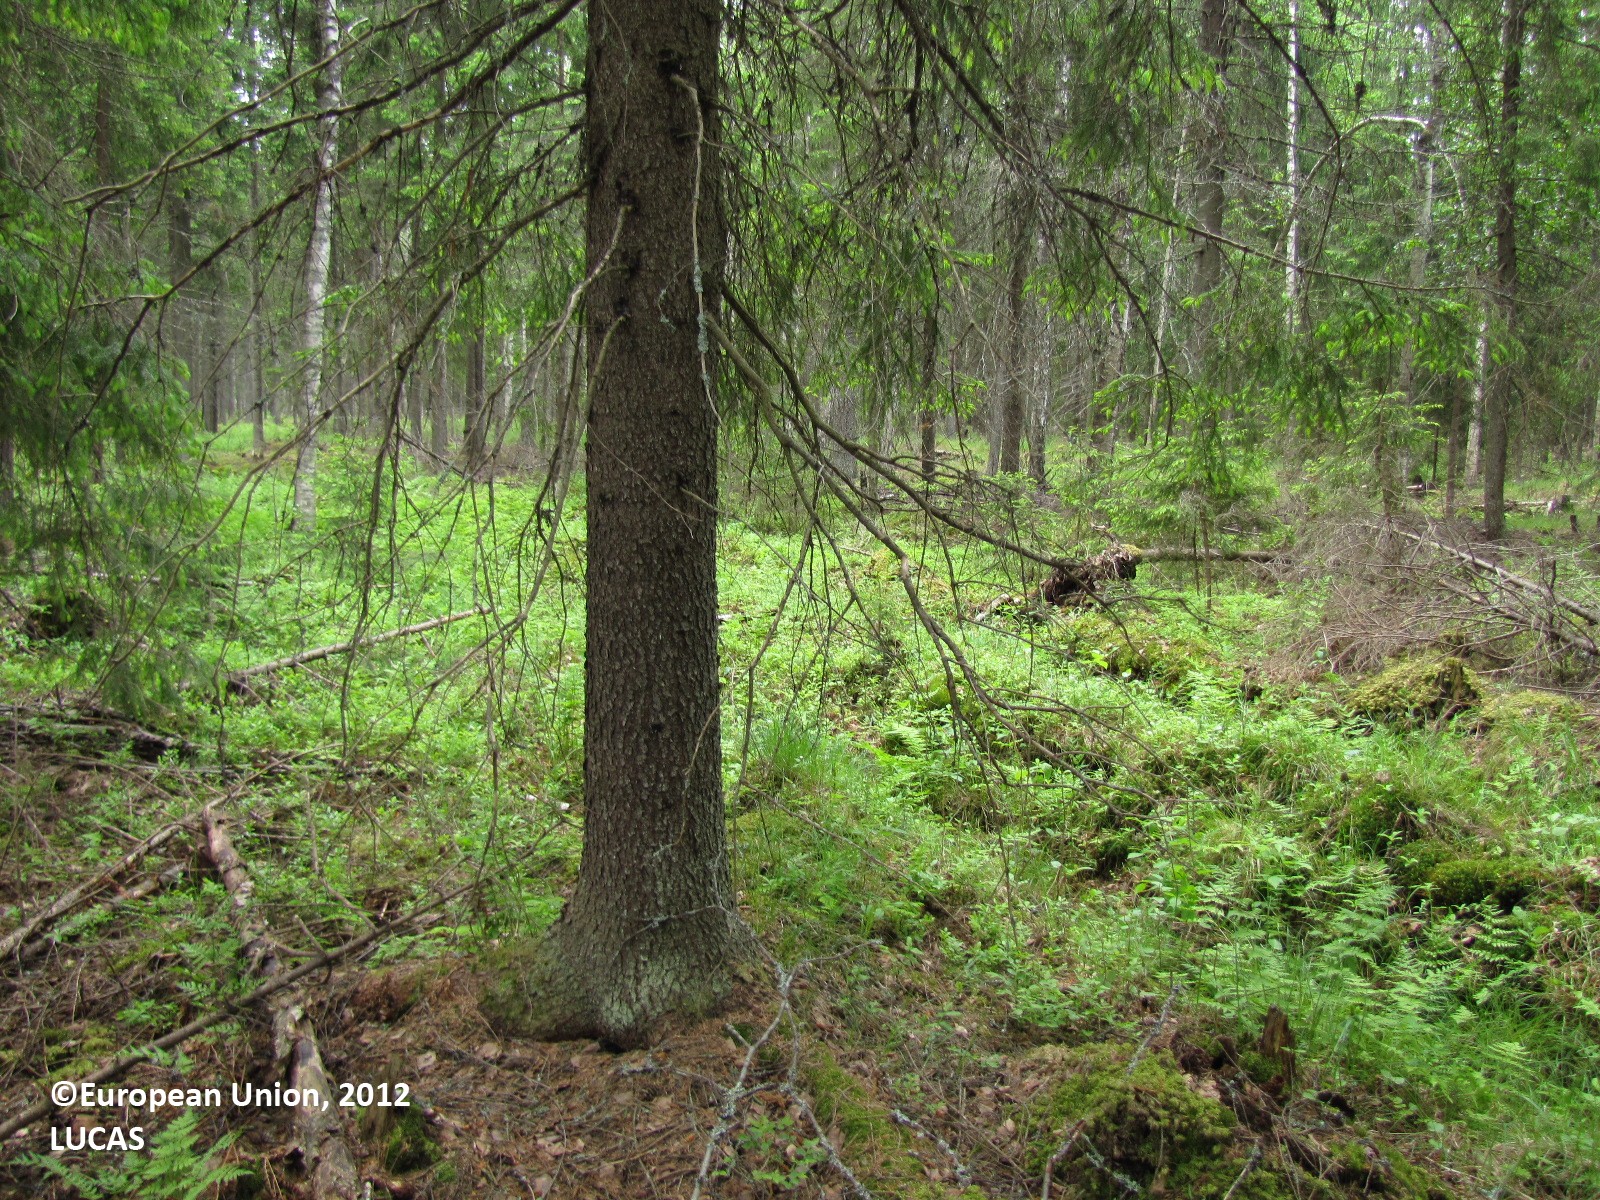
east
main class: Woodland
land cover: Spruce dominated mixed woodland
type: hemiboreal forest and nemoral coniferous forest and mixed broadleaved-coniferous forest
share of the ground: 50 - 75 %
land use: Forestry
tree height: > 5 m
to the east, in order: Spruce dominated mixed woodland; Ditches and canals; Spruce dominated mixed woodland; Ditches and canals; Spruce dominated coniferous woodland; Tracks; Spruce dominated mixed woodland
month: June
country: FI
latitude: 61.2366
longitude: 23.4377
